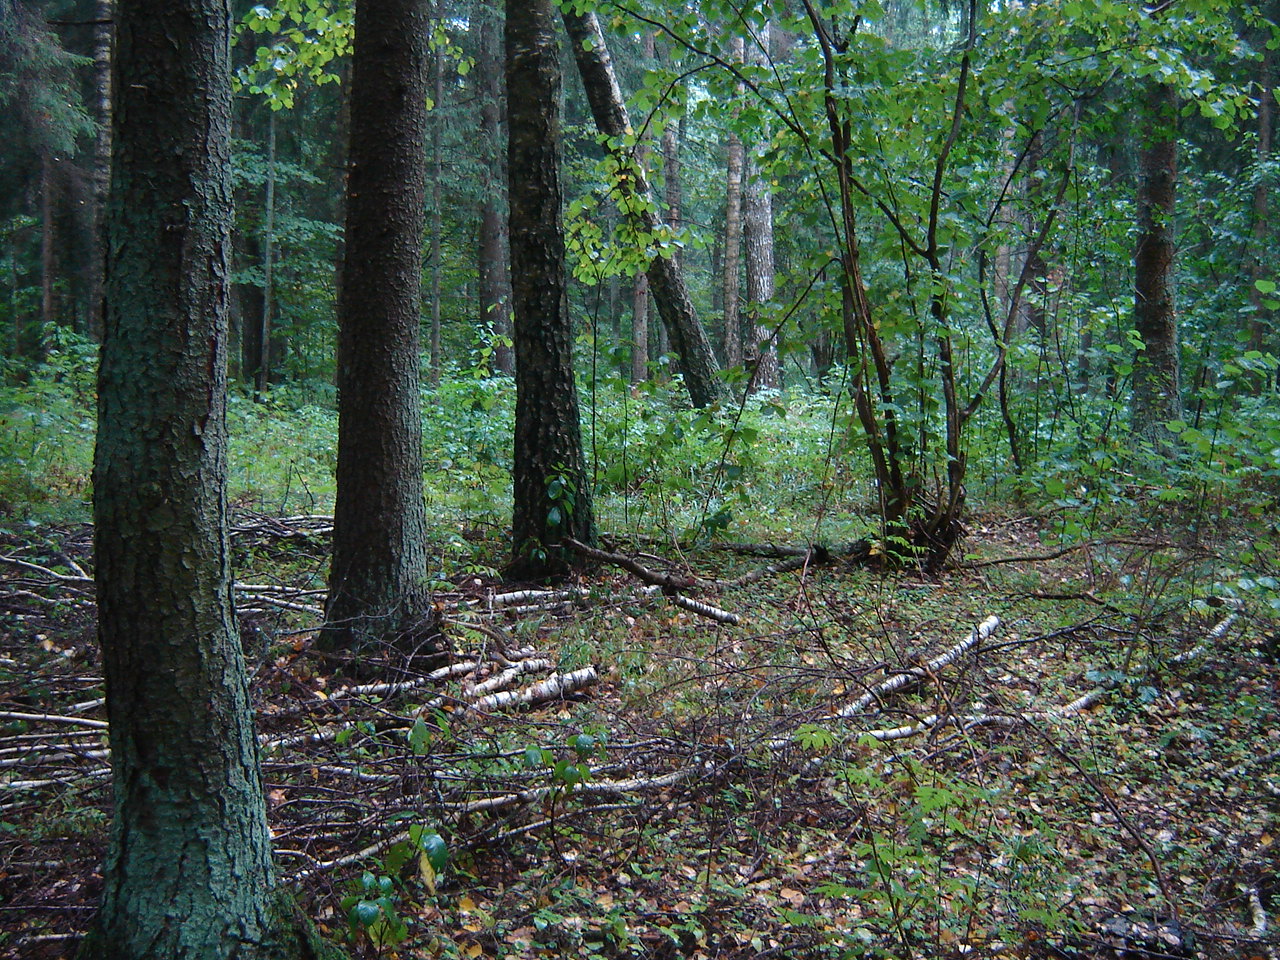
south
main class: Woodland
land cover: Spruce dominated mixed woodland
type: hemiboreal forest and nemoral coniferous forest and mixed broadleaved-coniferous forest
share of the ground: > 75 %
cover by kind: coniferous forest trees 60 %, broadleaved forest trees 30 %, herbaceous plants 5 %, unconsolidated bare surface 5 %
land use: Forestry
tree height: > 5 m
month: September
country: LT
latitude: 54.4448
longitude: 25.0905
